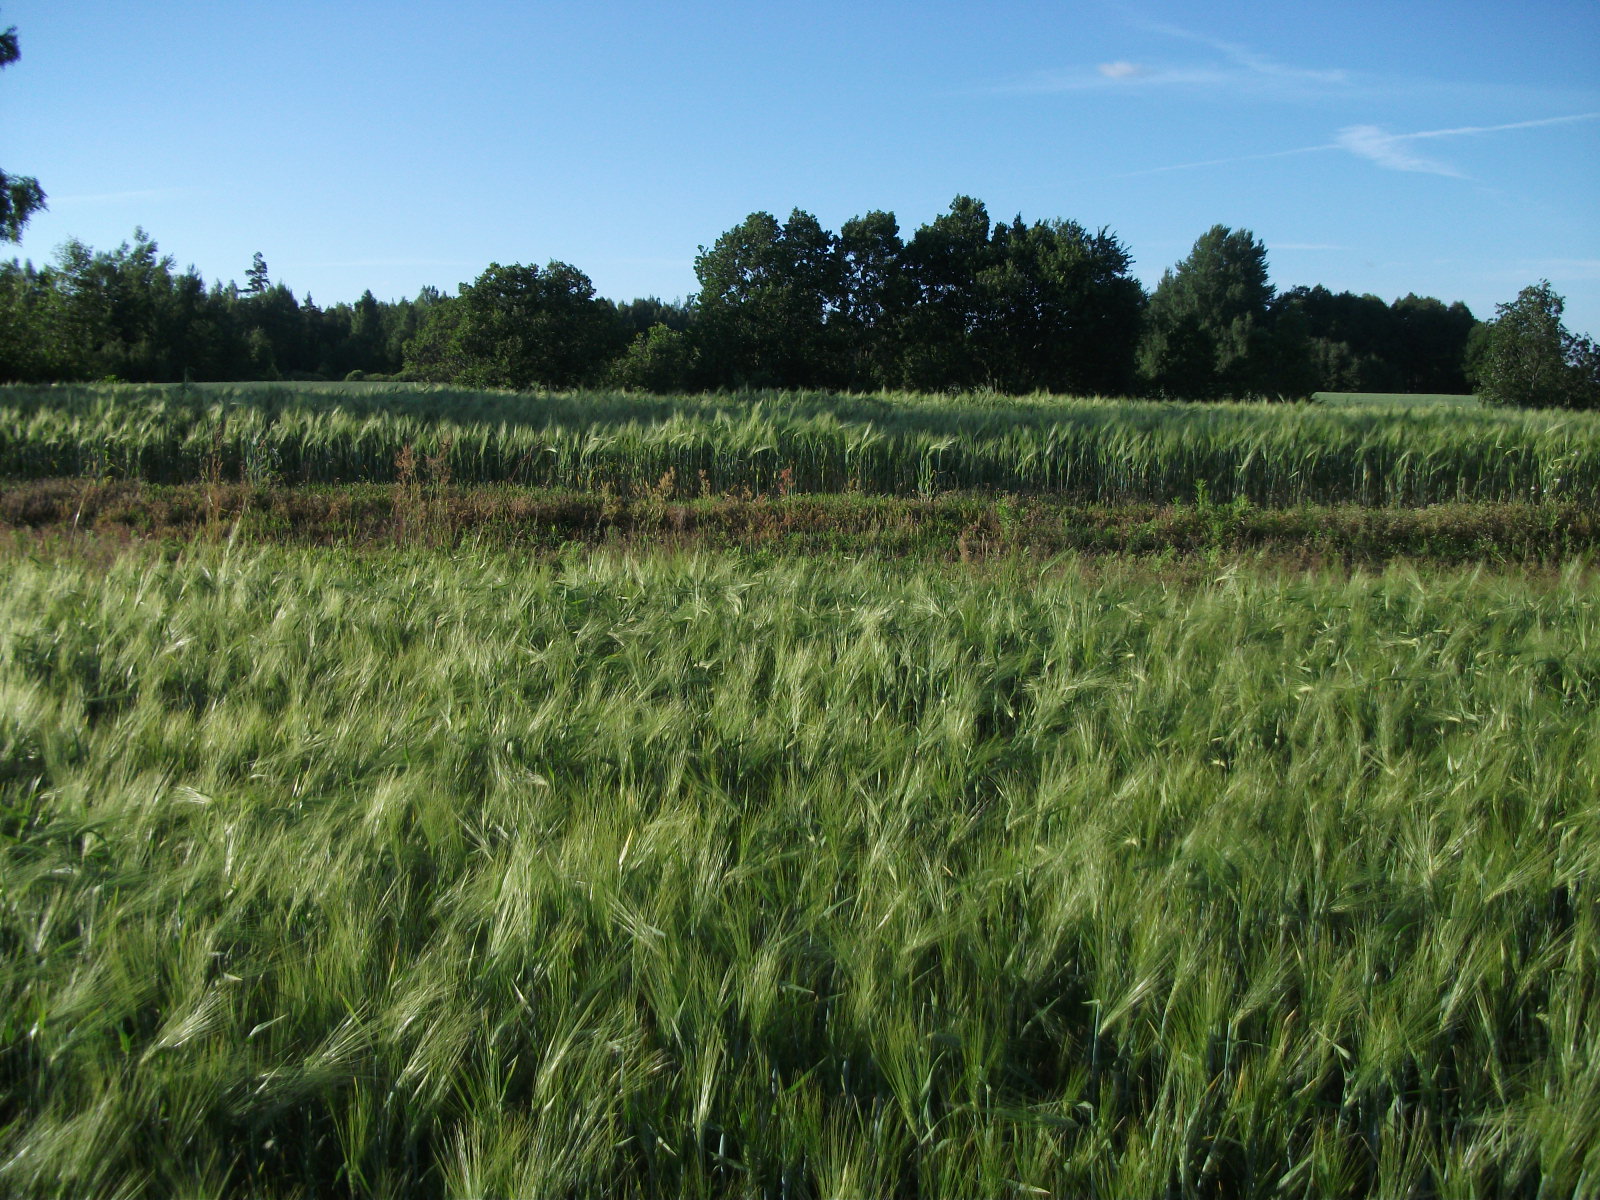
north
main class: Cropland
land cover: Barley
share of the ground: > 75 %
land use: Agriculture (excluding fallow land and kitchen gardens)
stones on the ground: < 10 %
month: July
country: LV
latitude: 56.8102
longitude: 26.5771
